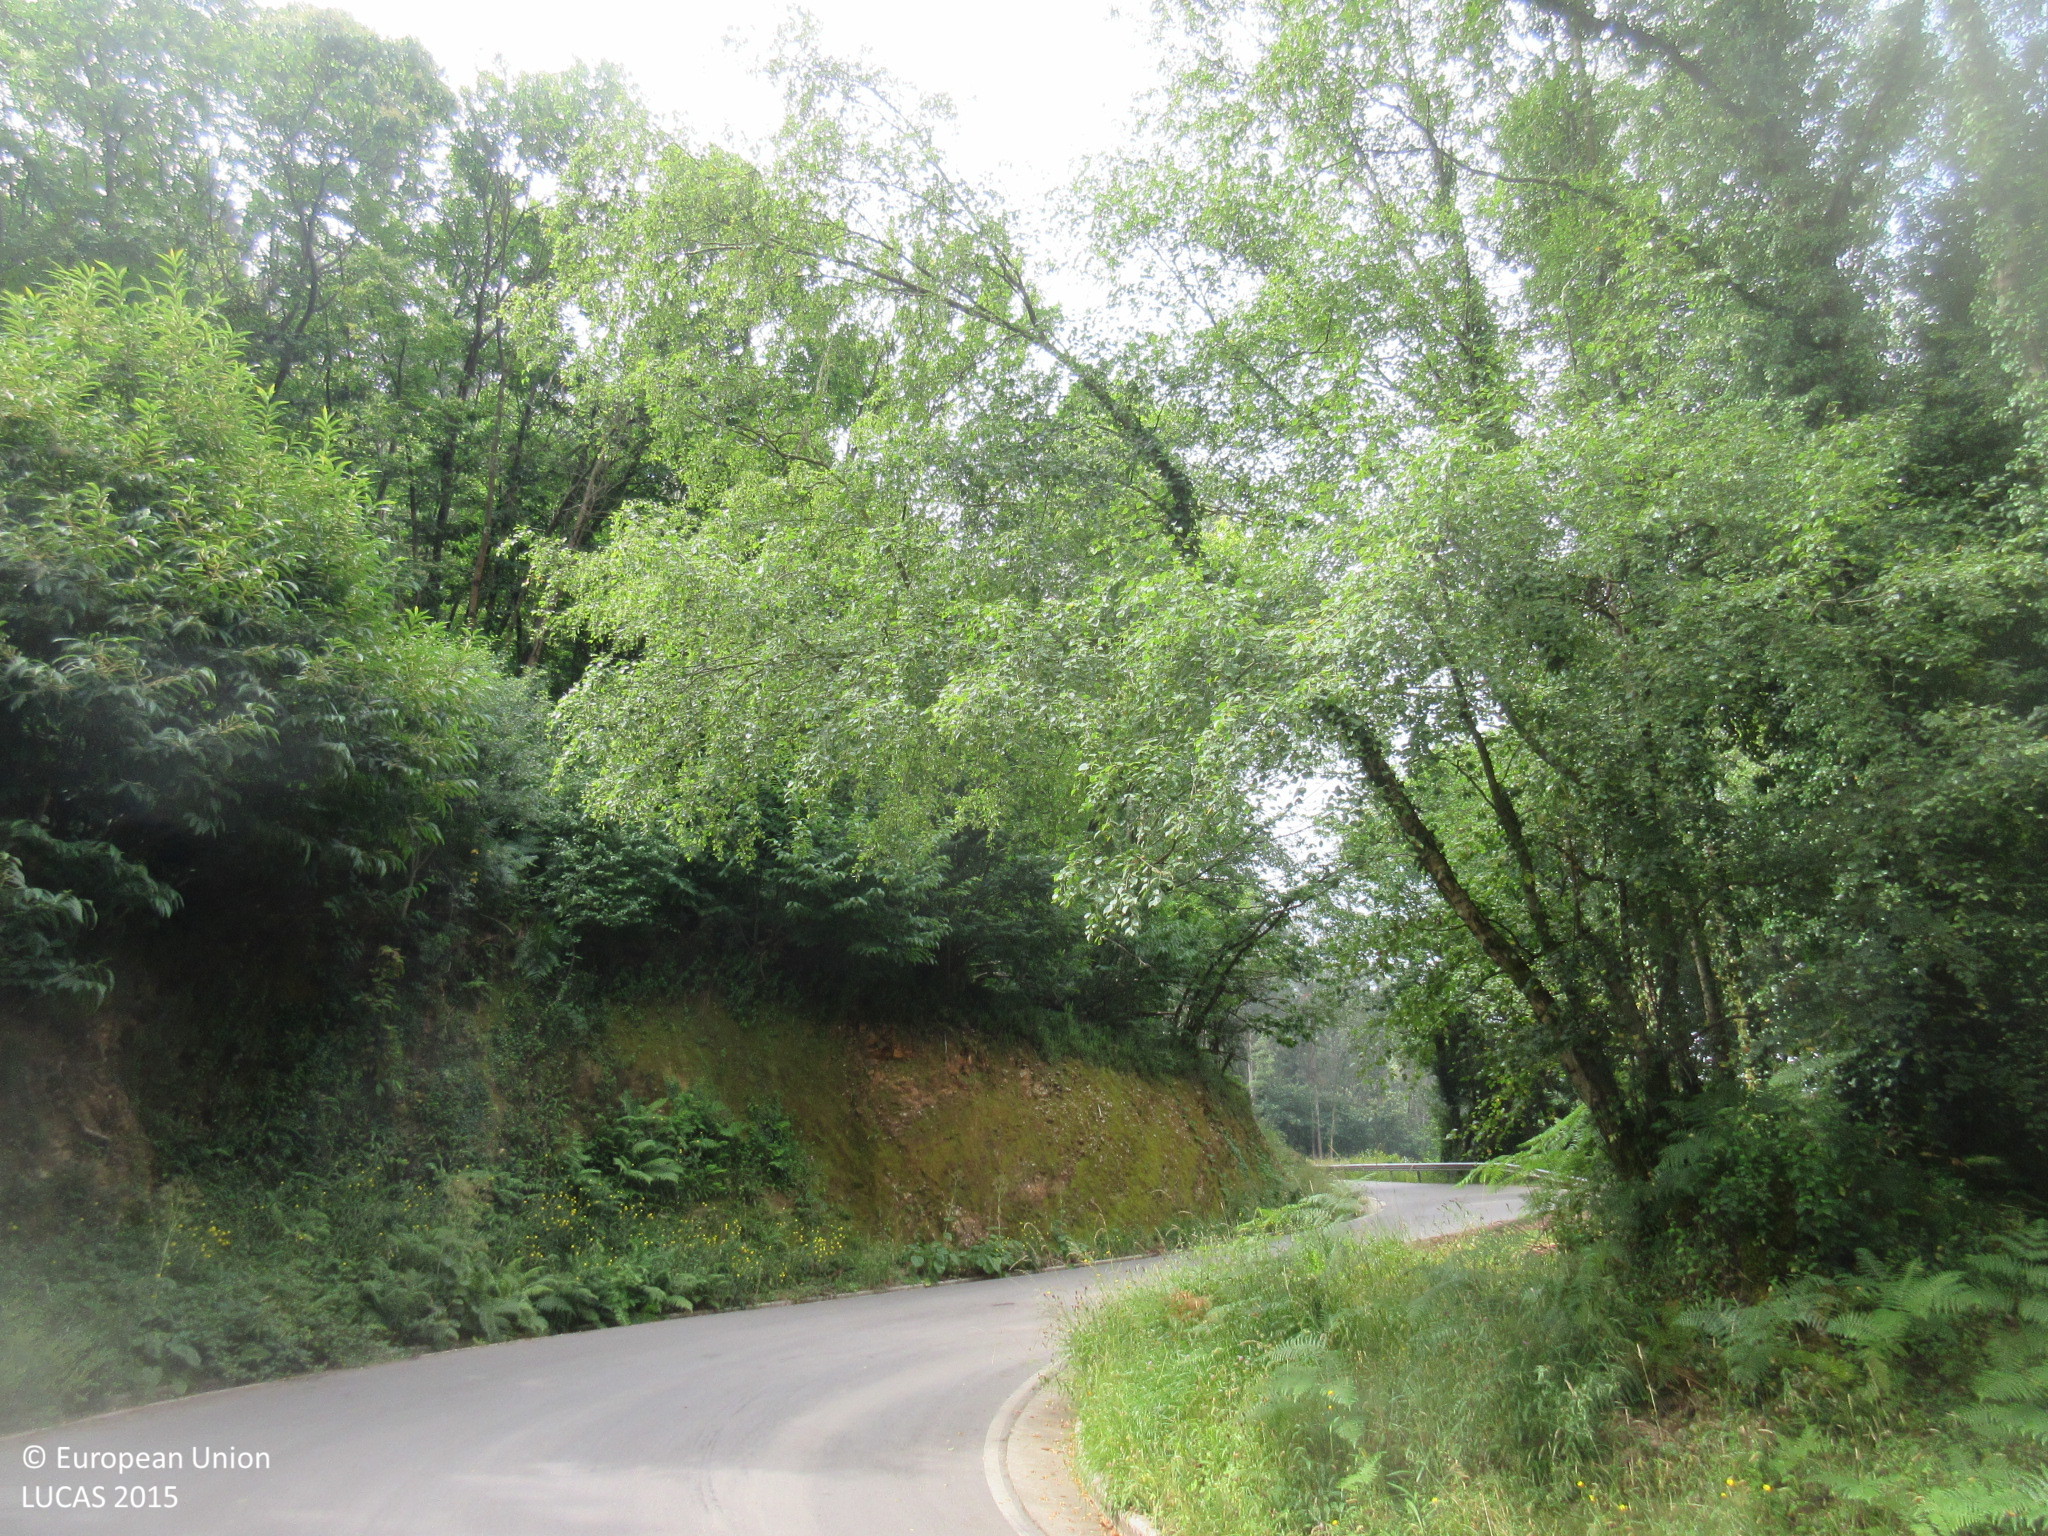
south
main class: Woodland
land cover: Broadleaved woodland
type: thermophilous deciduous forest
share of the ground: > 75 %
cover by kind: broadleaved forest trees 95 %, shrubs 5 %
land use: Forestry
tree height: > 5 m
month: July
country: ES
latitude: 43.4474
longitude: -6.3495
